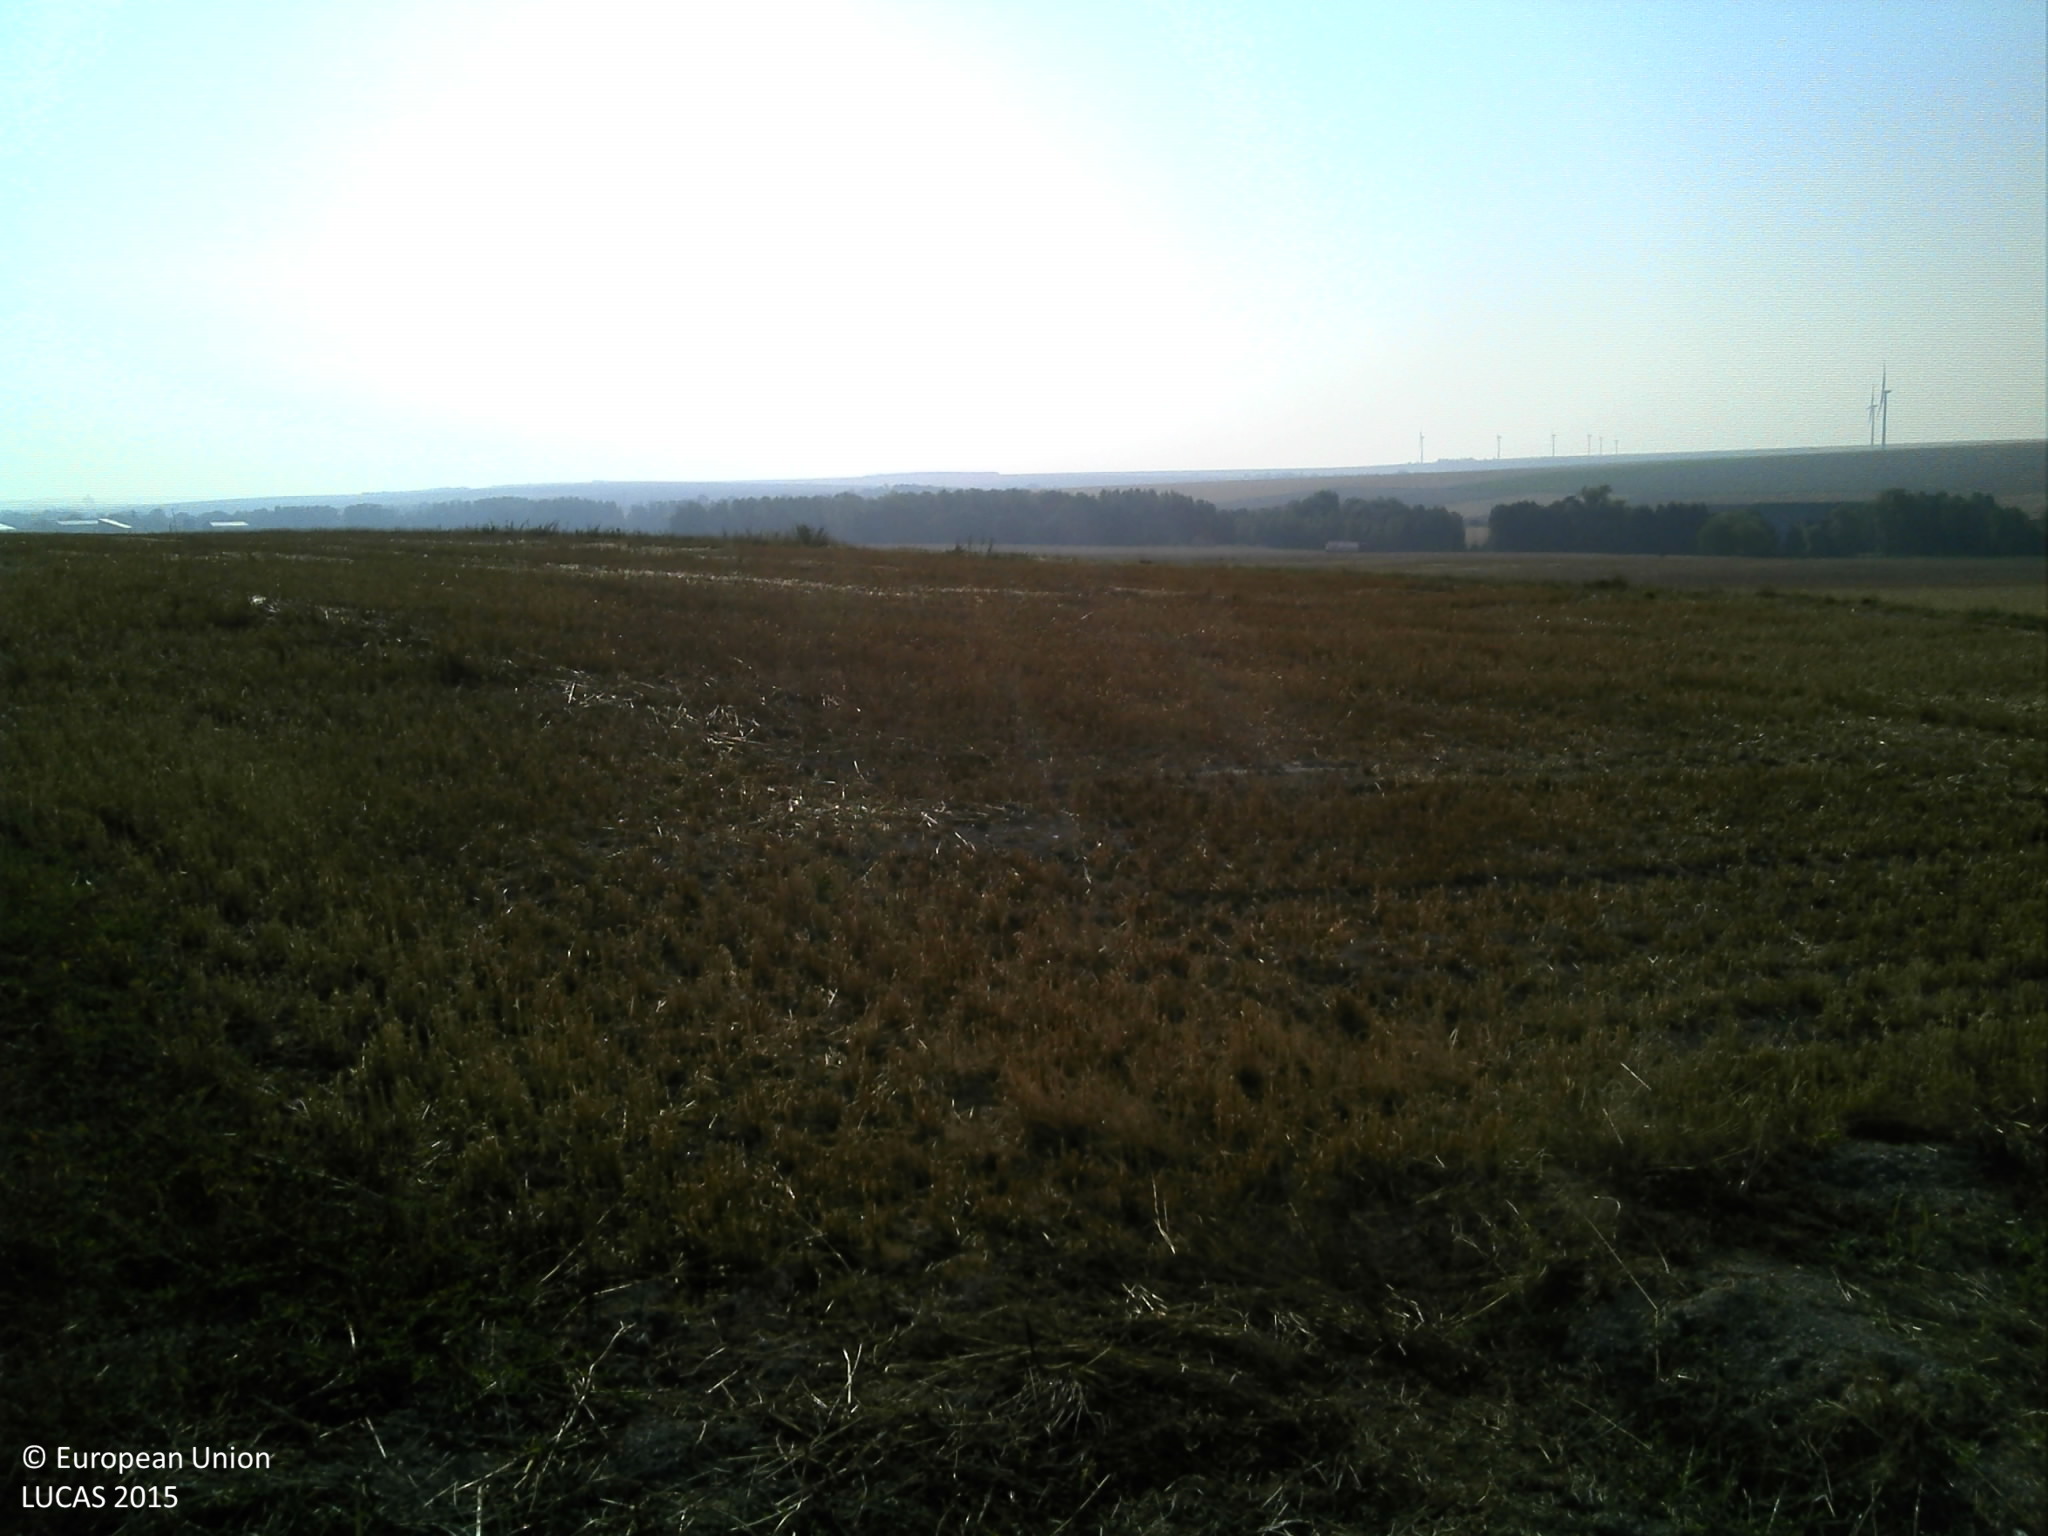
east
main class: Cropland
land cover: Lucerne
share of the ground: > 75 %
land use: Agriculture (excluding fallow land and kitchen gardens)
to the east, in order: Grass margins; Lucerne; Common wheat; Grass margins; Tracks; Grass margins; Common wheat
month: August
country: FR
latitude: 48.9004
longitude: 4.5539
